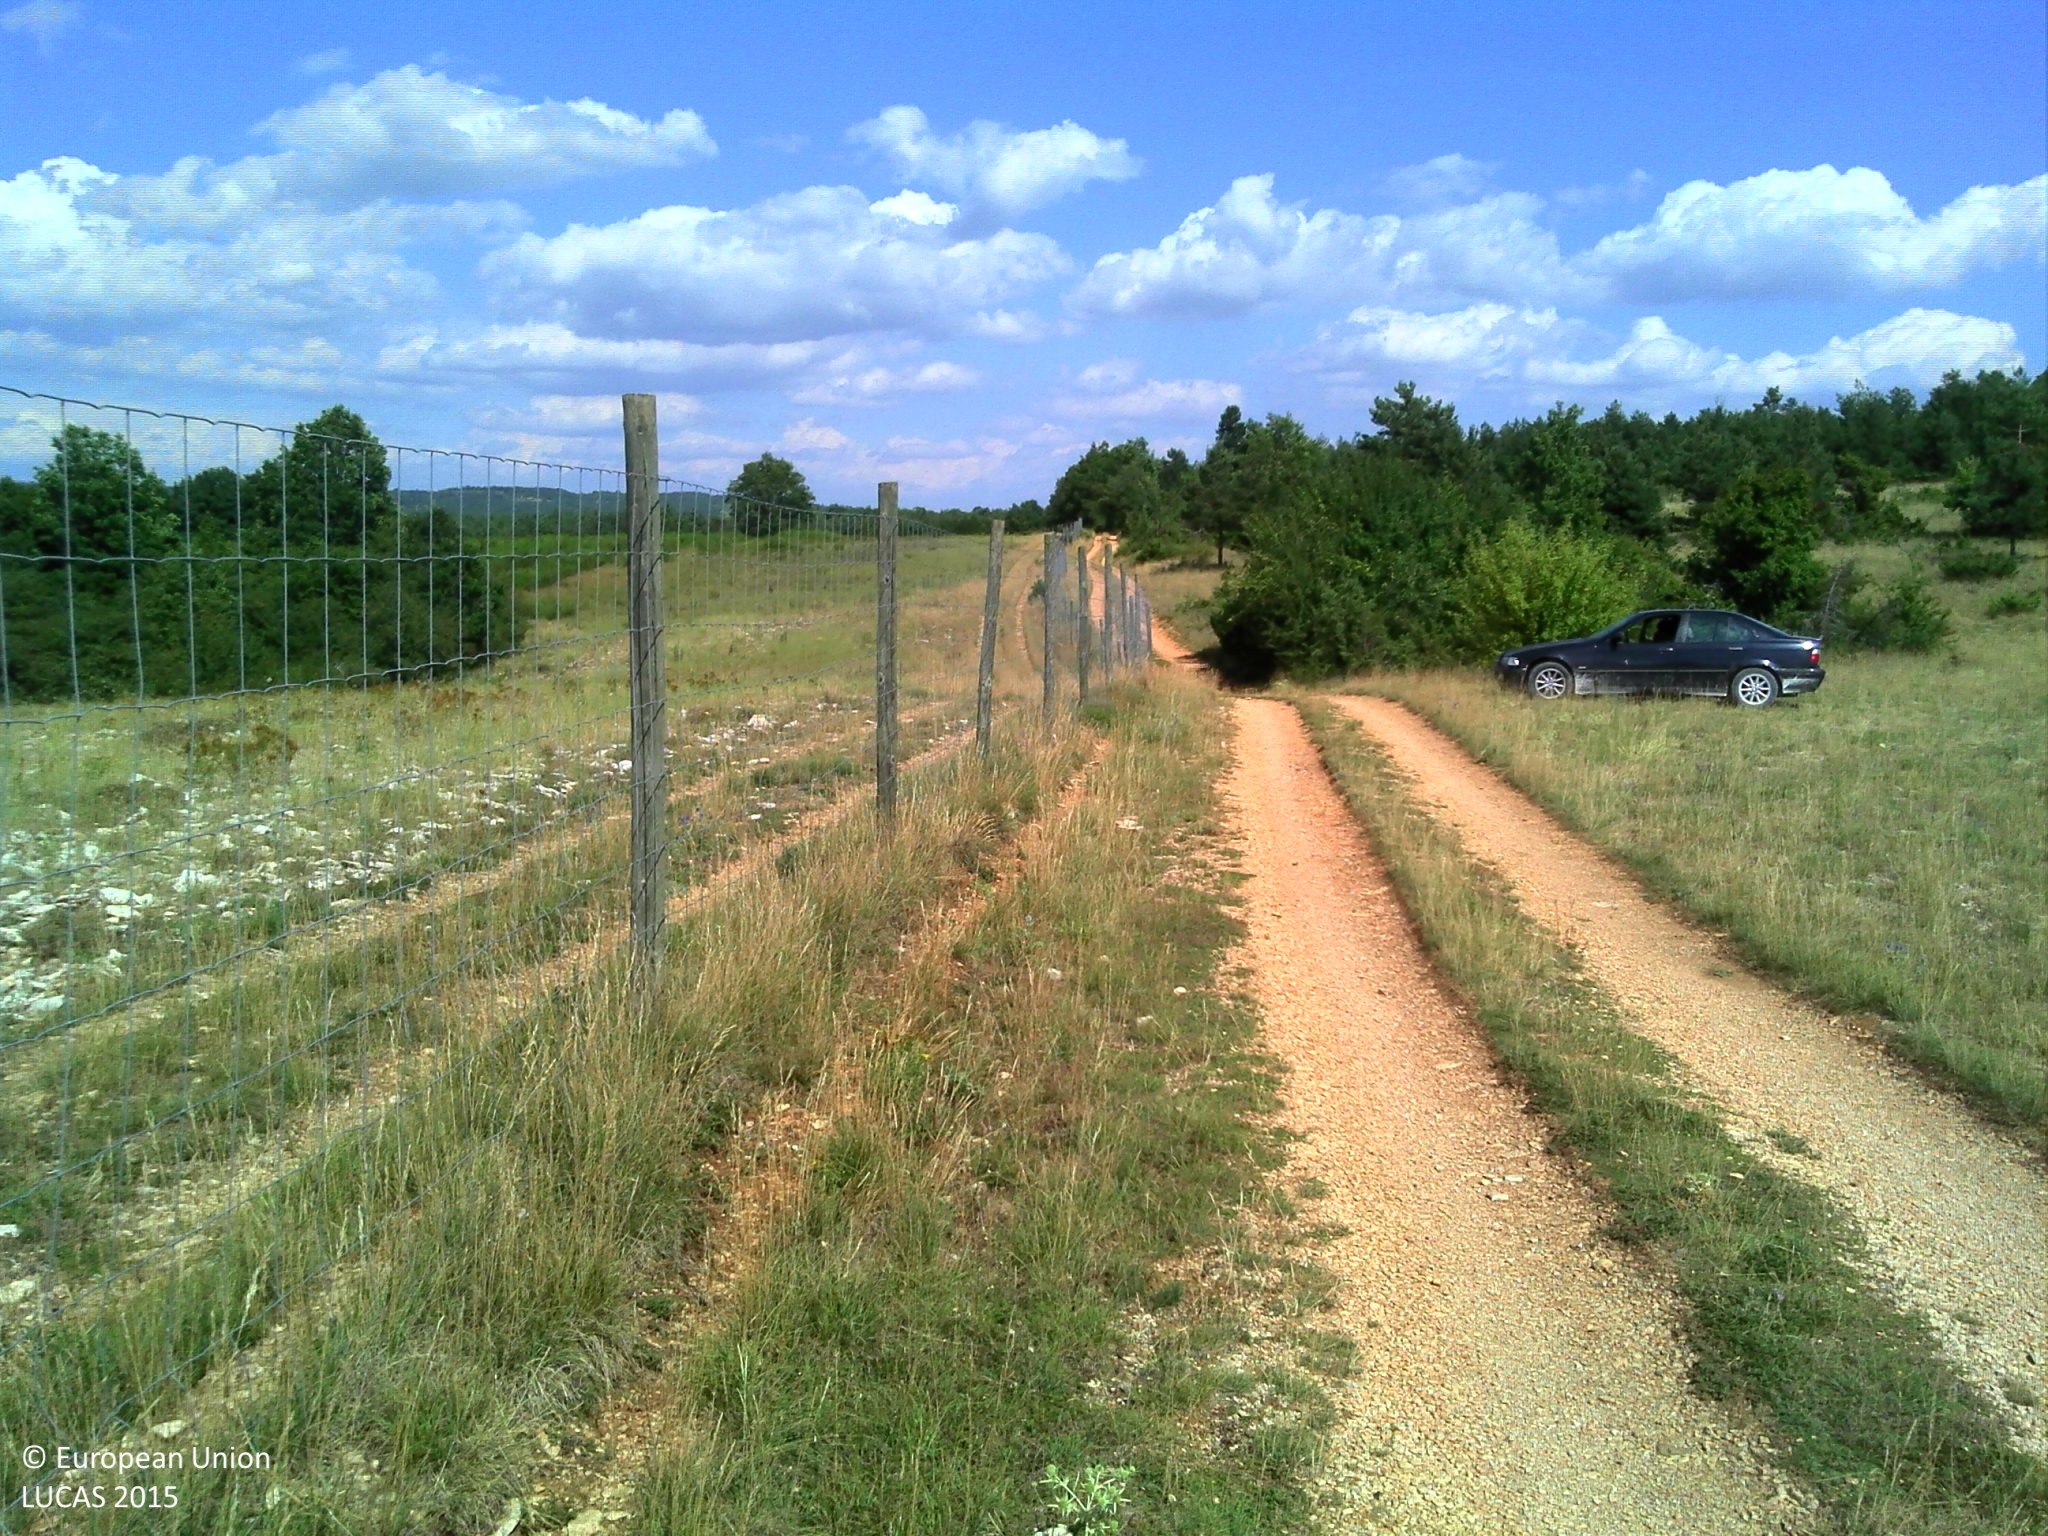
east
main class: Grassland
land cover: Spontaneously vegetated surfaces
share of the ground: > 75 %
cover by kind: herbaceous plants 70 %, unconsolidated bare surface 25 %, shrubs 5 %
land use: Semi-natural and natural areas not in use
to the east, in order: Spontaneously vegetated surfaces; Broadleaved woodland
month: July
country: FR
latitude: 44.0194
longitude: 5.5297
